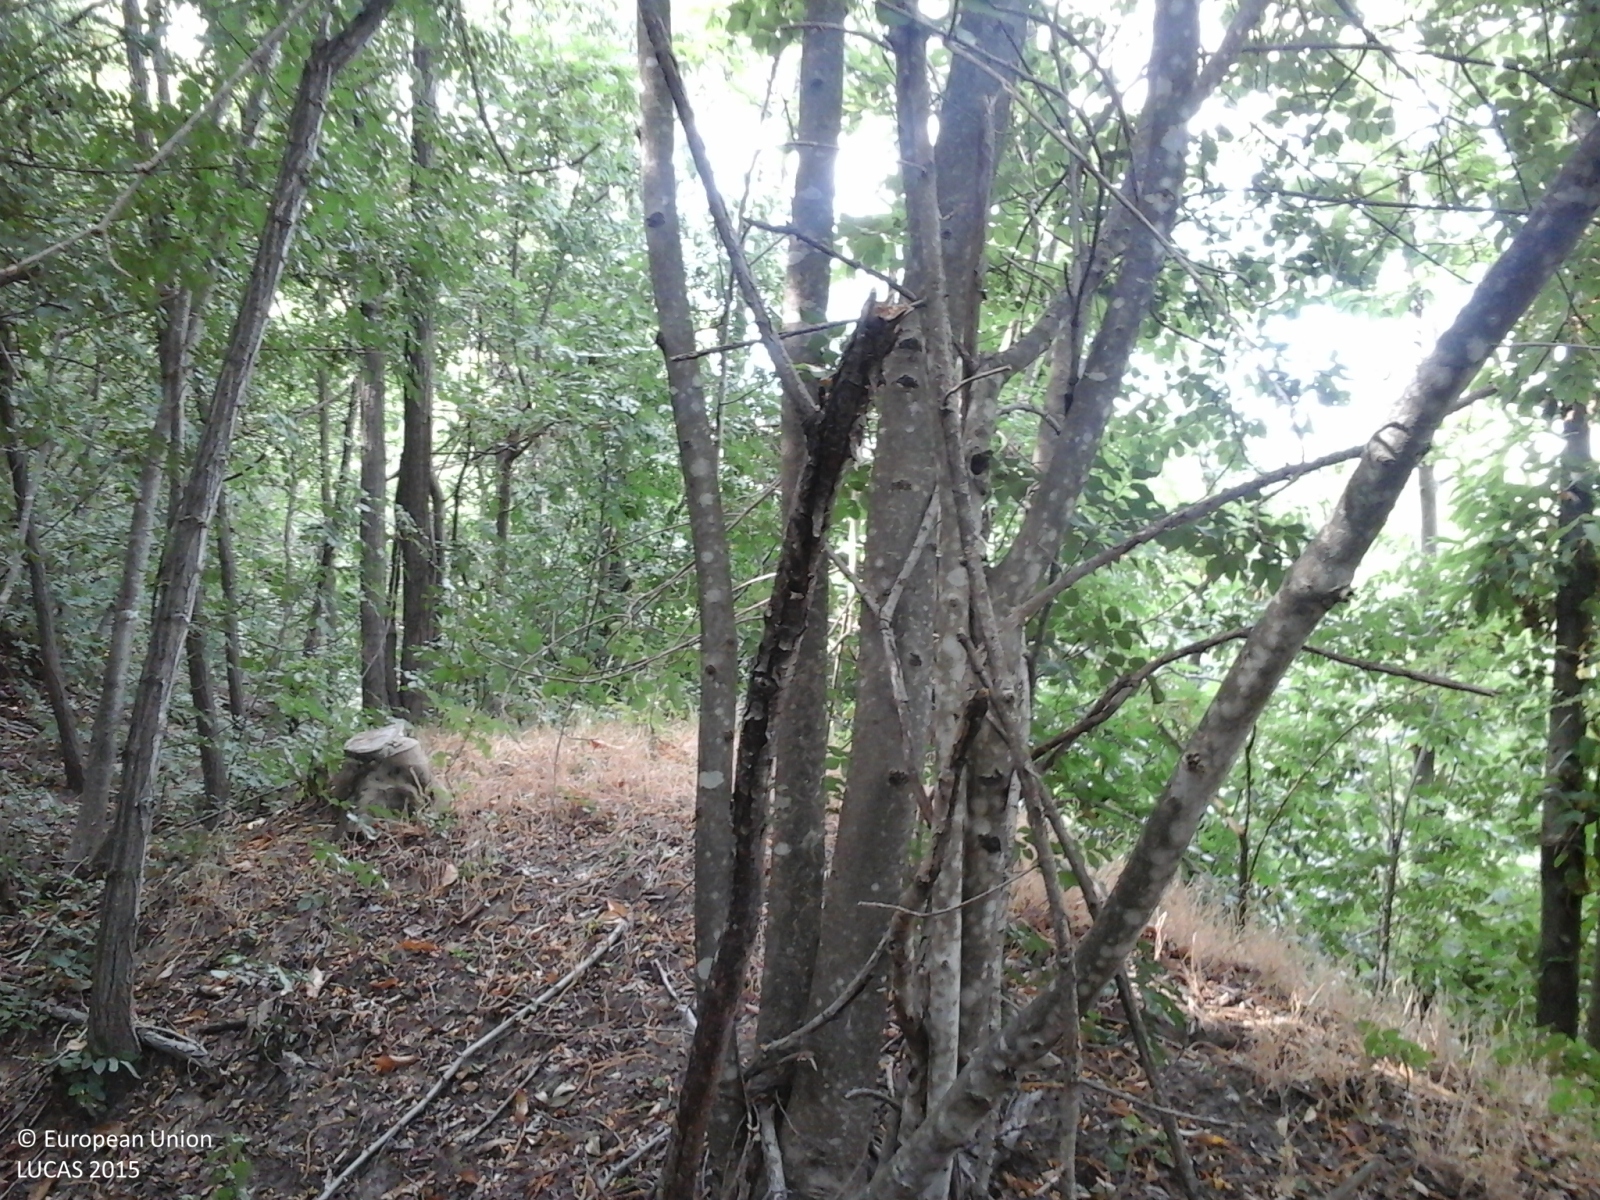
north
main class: Artificial land
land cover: Other artificial areas
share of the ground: 10 - 25 %
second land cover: Broadleaved woodland
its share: > 75 %
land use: Electricity, gas and thermal power distribution
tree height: > 5 m
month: July
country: IT
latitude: 44.4046
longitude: 8.0580
